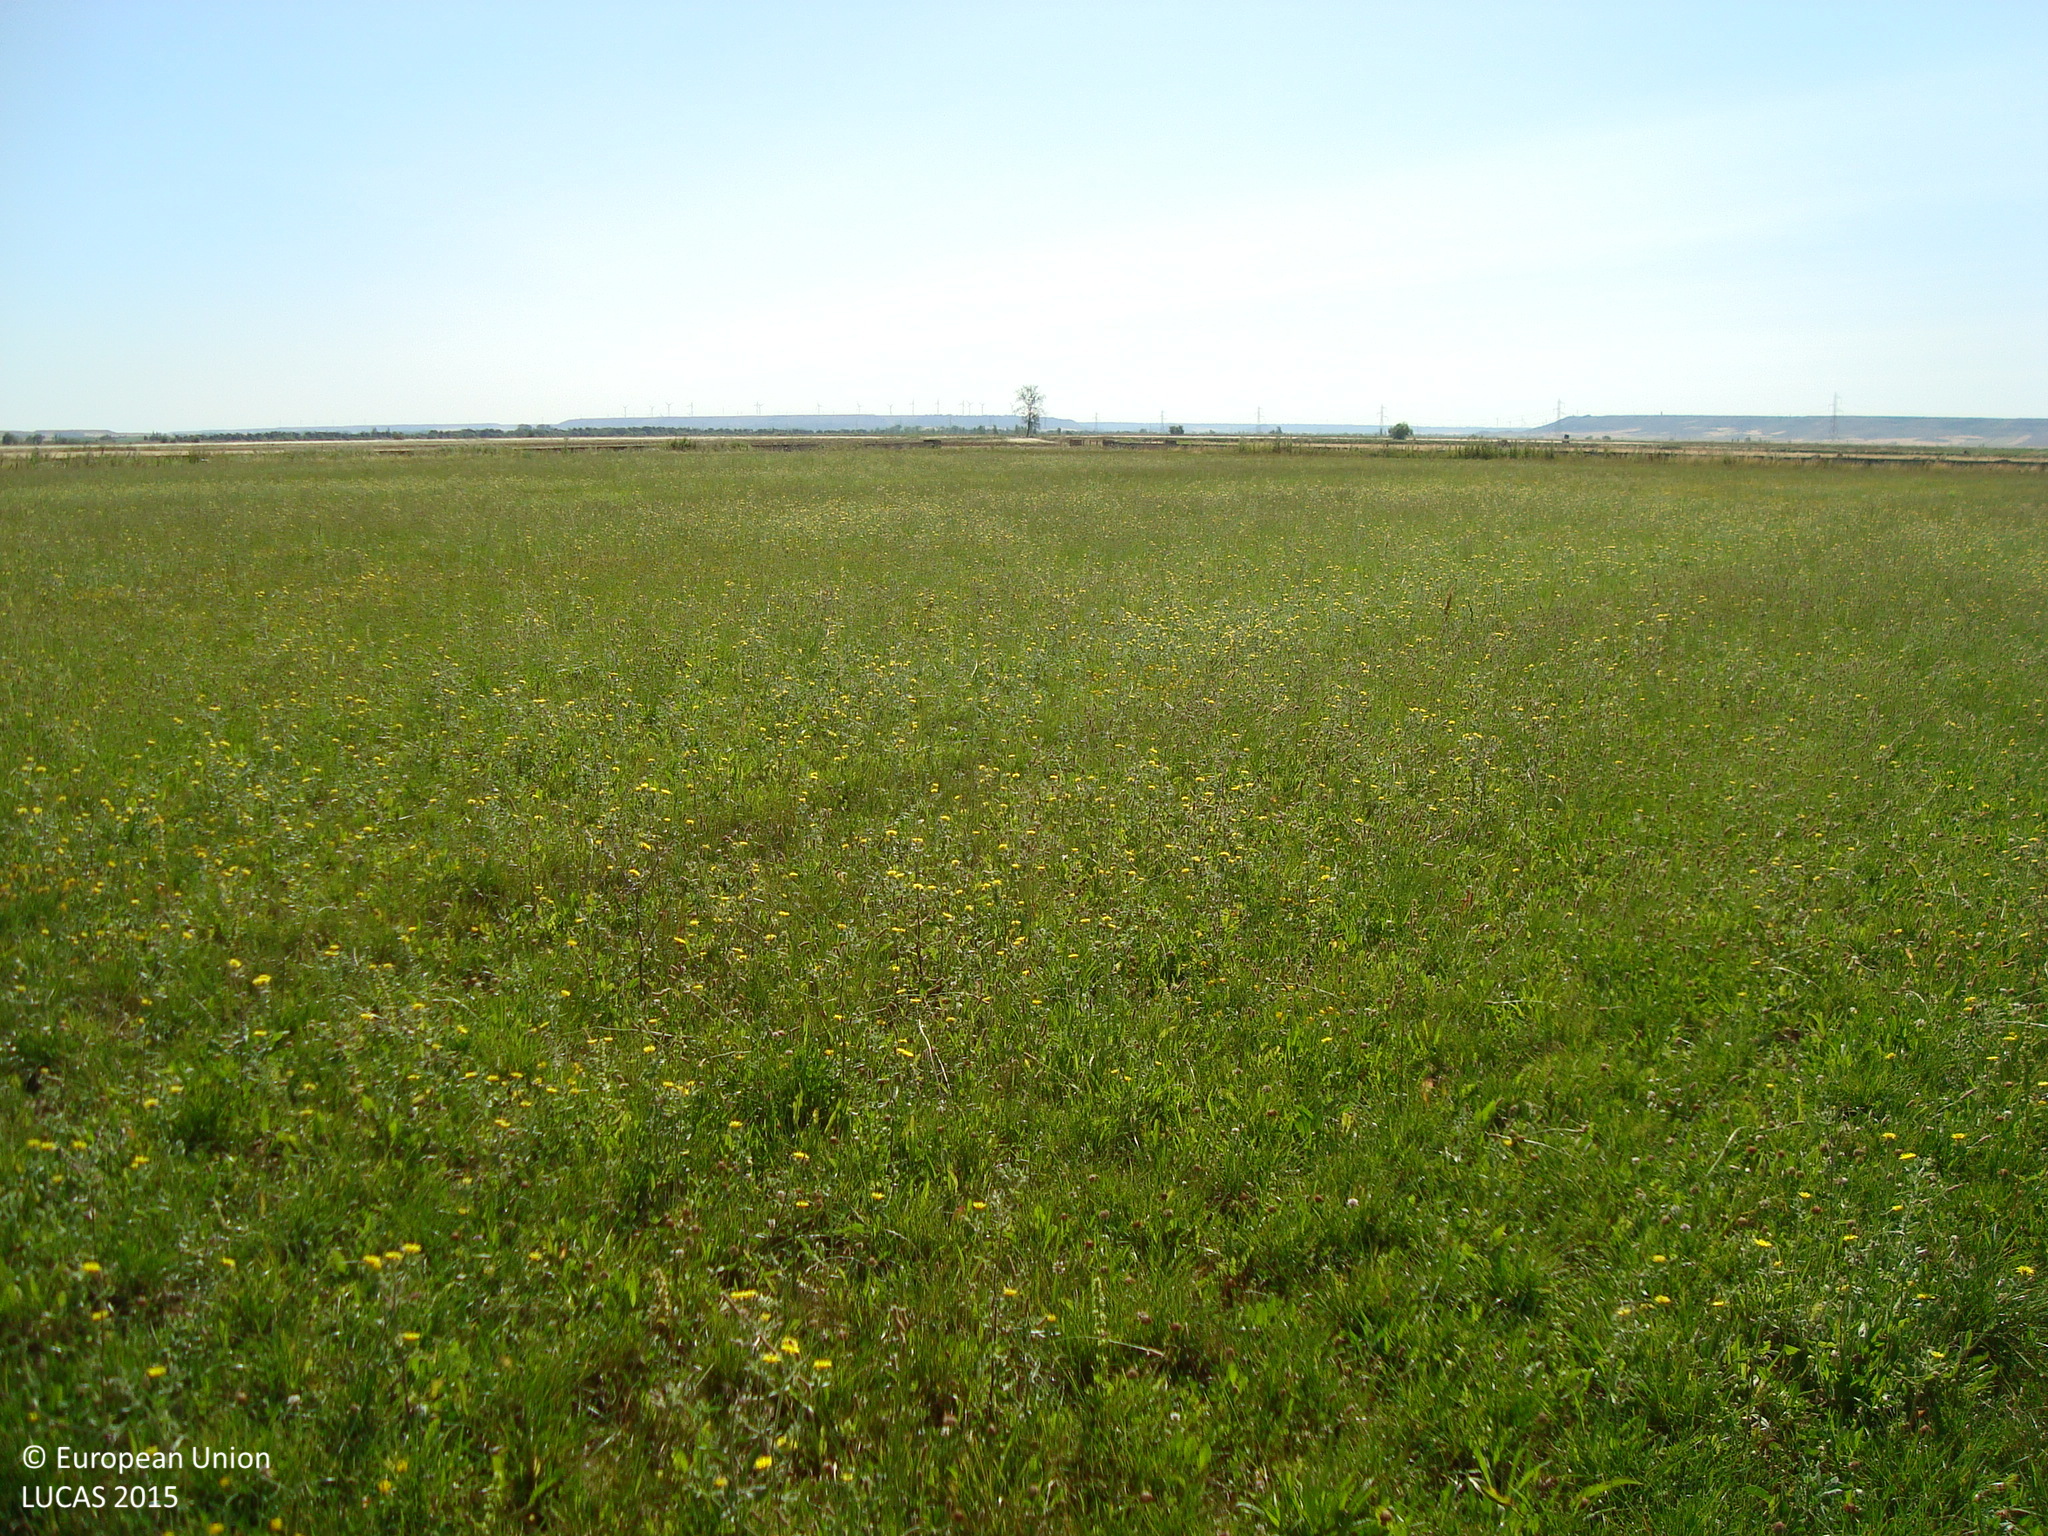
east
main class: Cropland
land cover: Other leguminous and mixtures for fodder
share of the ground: > 75 %
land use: Agriculture (excluding fallow land and kitchen gardens)
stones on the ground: > 50 %
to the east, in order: Other leguminous and mixtures for fodder; Ditches and canals; Inland fresh running water; Tracks; Ditches and canals; Inland fresh running water; Ditches and canals; Tracks; Rivers and streams; Tracks; Rivers and streams; Other bare soil
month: July
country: ES
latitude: 42.0505
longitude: -4.7054
